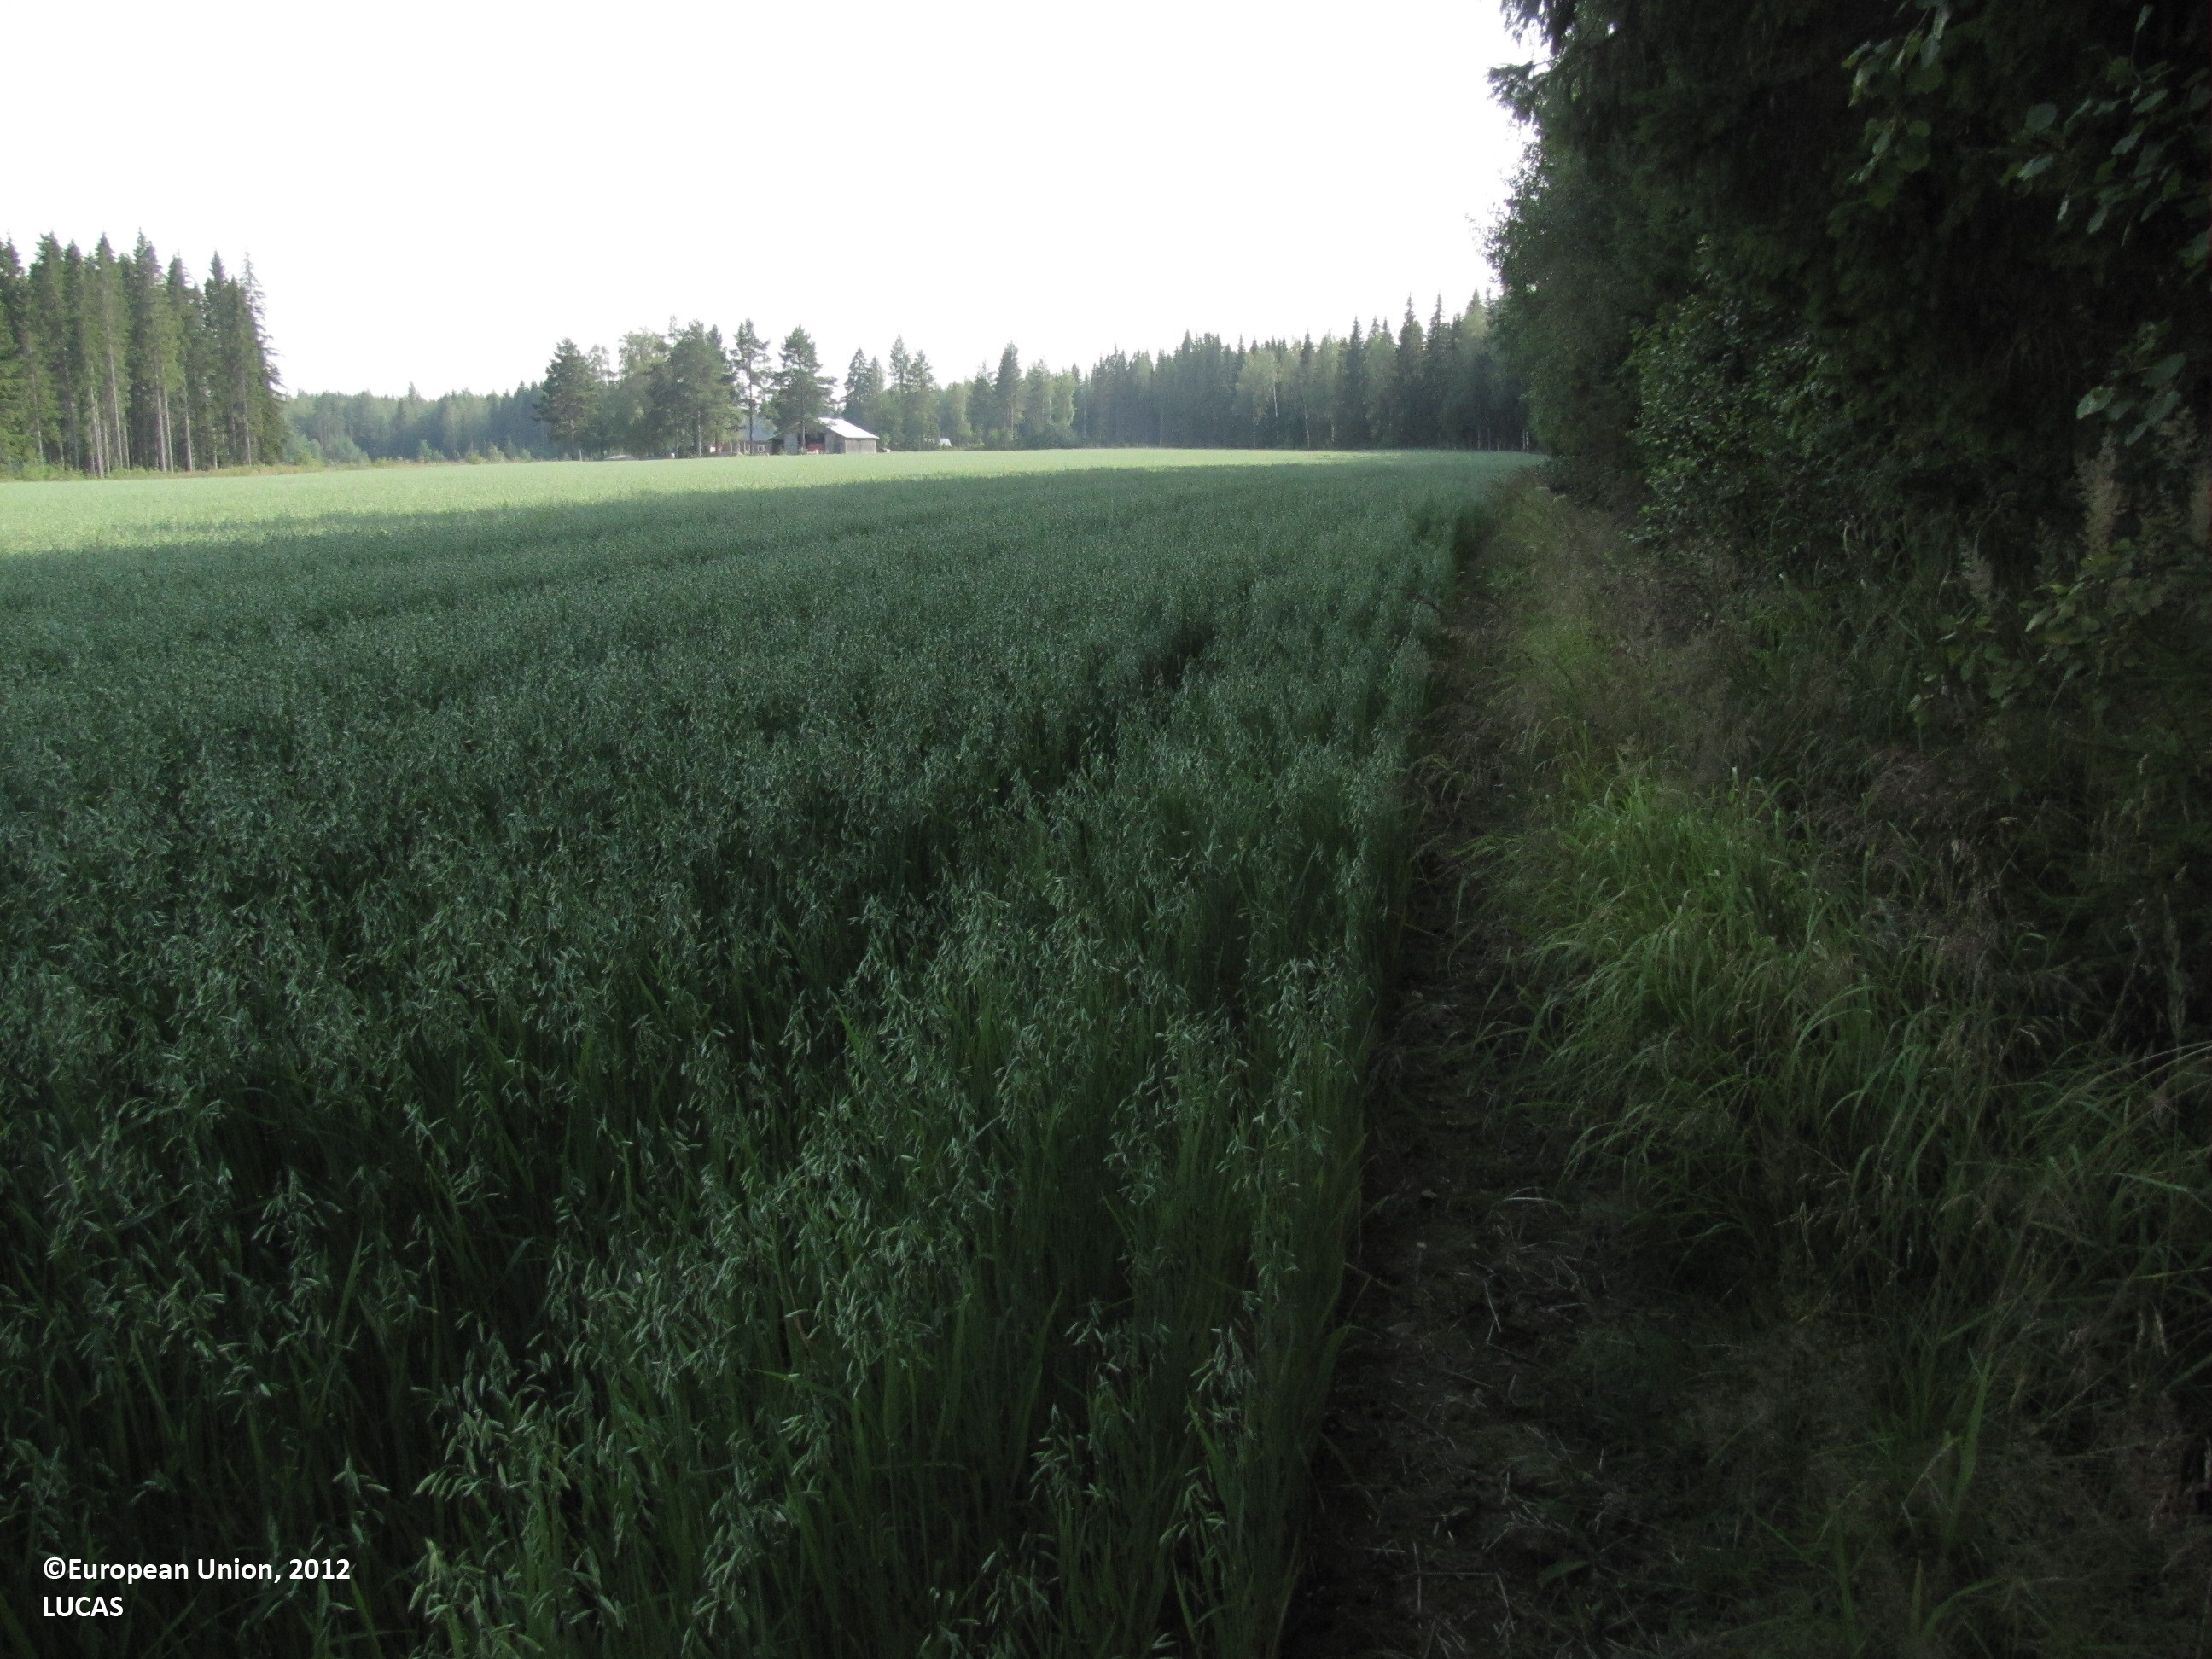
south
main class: Cropland
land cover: Oats
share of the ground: > 75 %
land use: Agriculture (excluding fallow land and kitchen gardens)
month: July
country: FI
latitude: 61.9564
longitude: 22.9751
